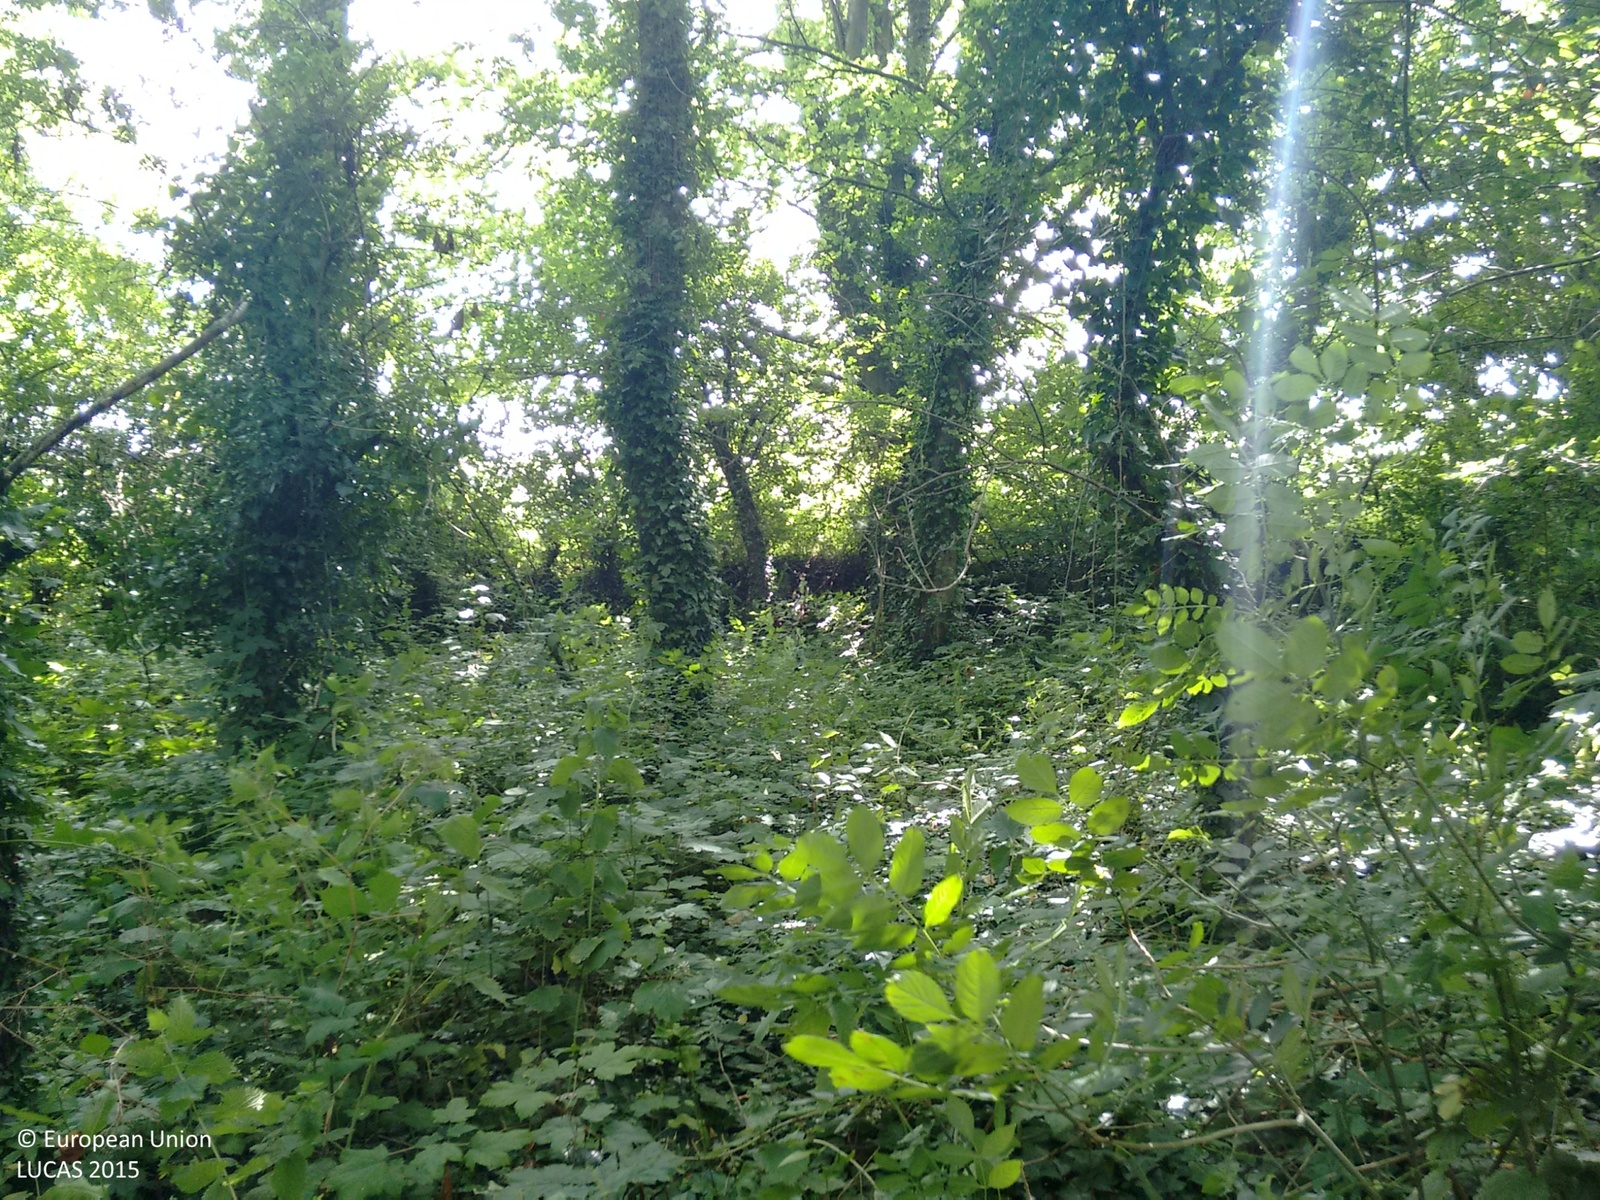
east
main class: Woodland
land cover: Broadleaved woodland
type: mesophytic deciduous forest
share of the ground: > 75 %
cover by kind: broadleaved forest trees 100 %
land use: Semi-natural and natural areas not in use
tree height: > 5 m
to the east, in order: Broadleaved woodland; Fences; Broadleaved woodland; Grass margins; Tracks; Permanent industrial crops; Managed hedges; Shruby margins; Common wheat
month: August
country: GB
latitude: 50.5368
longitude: -3.5592
